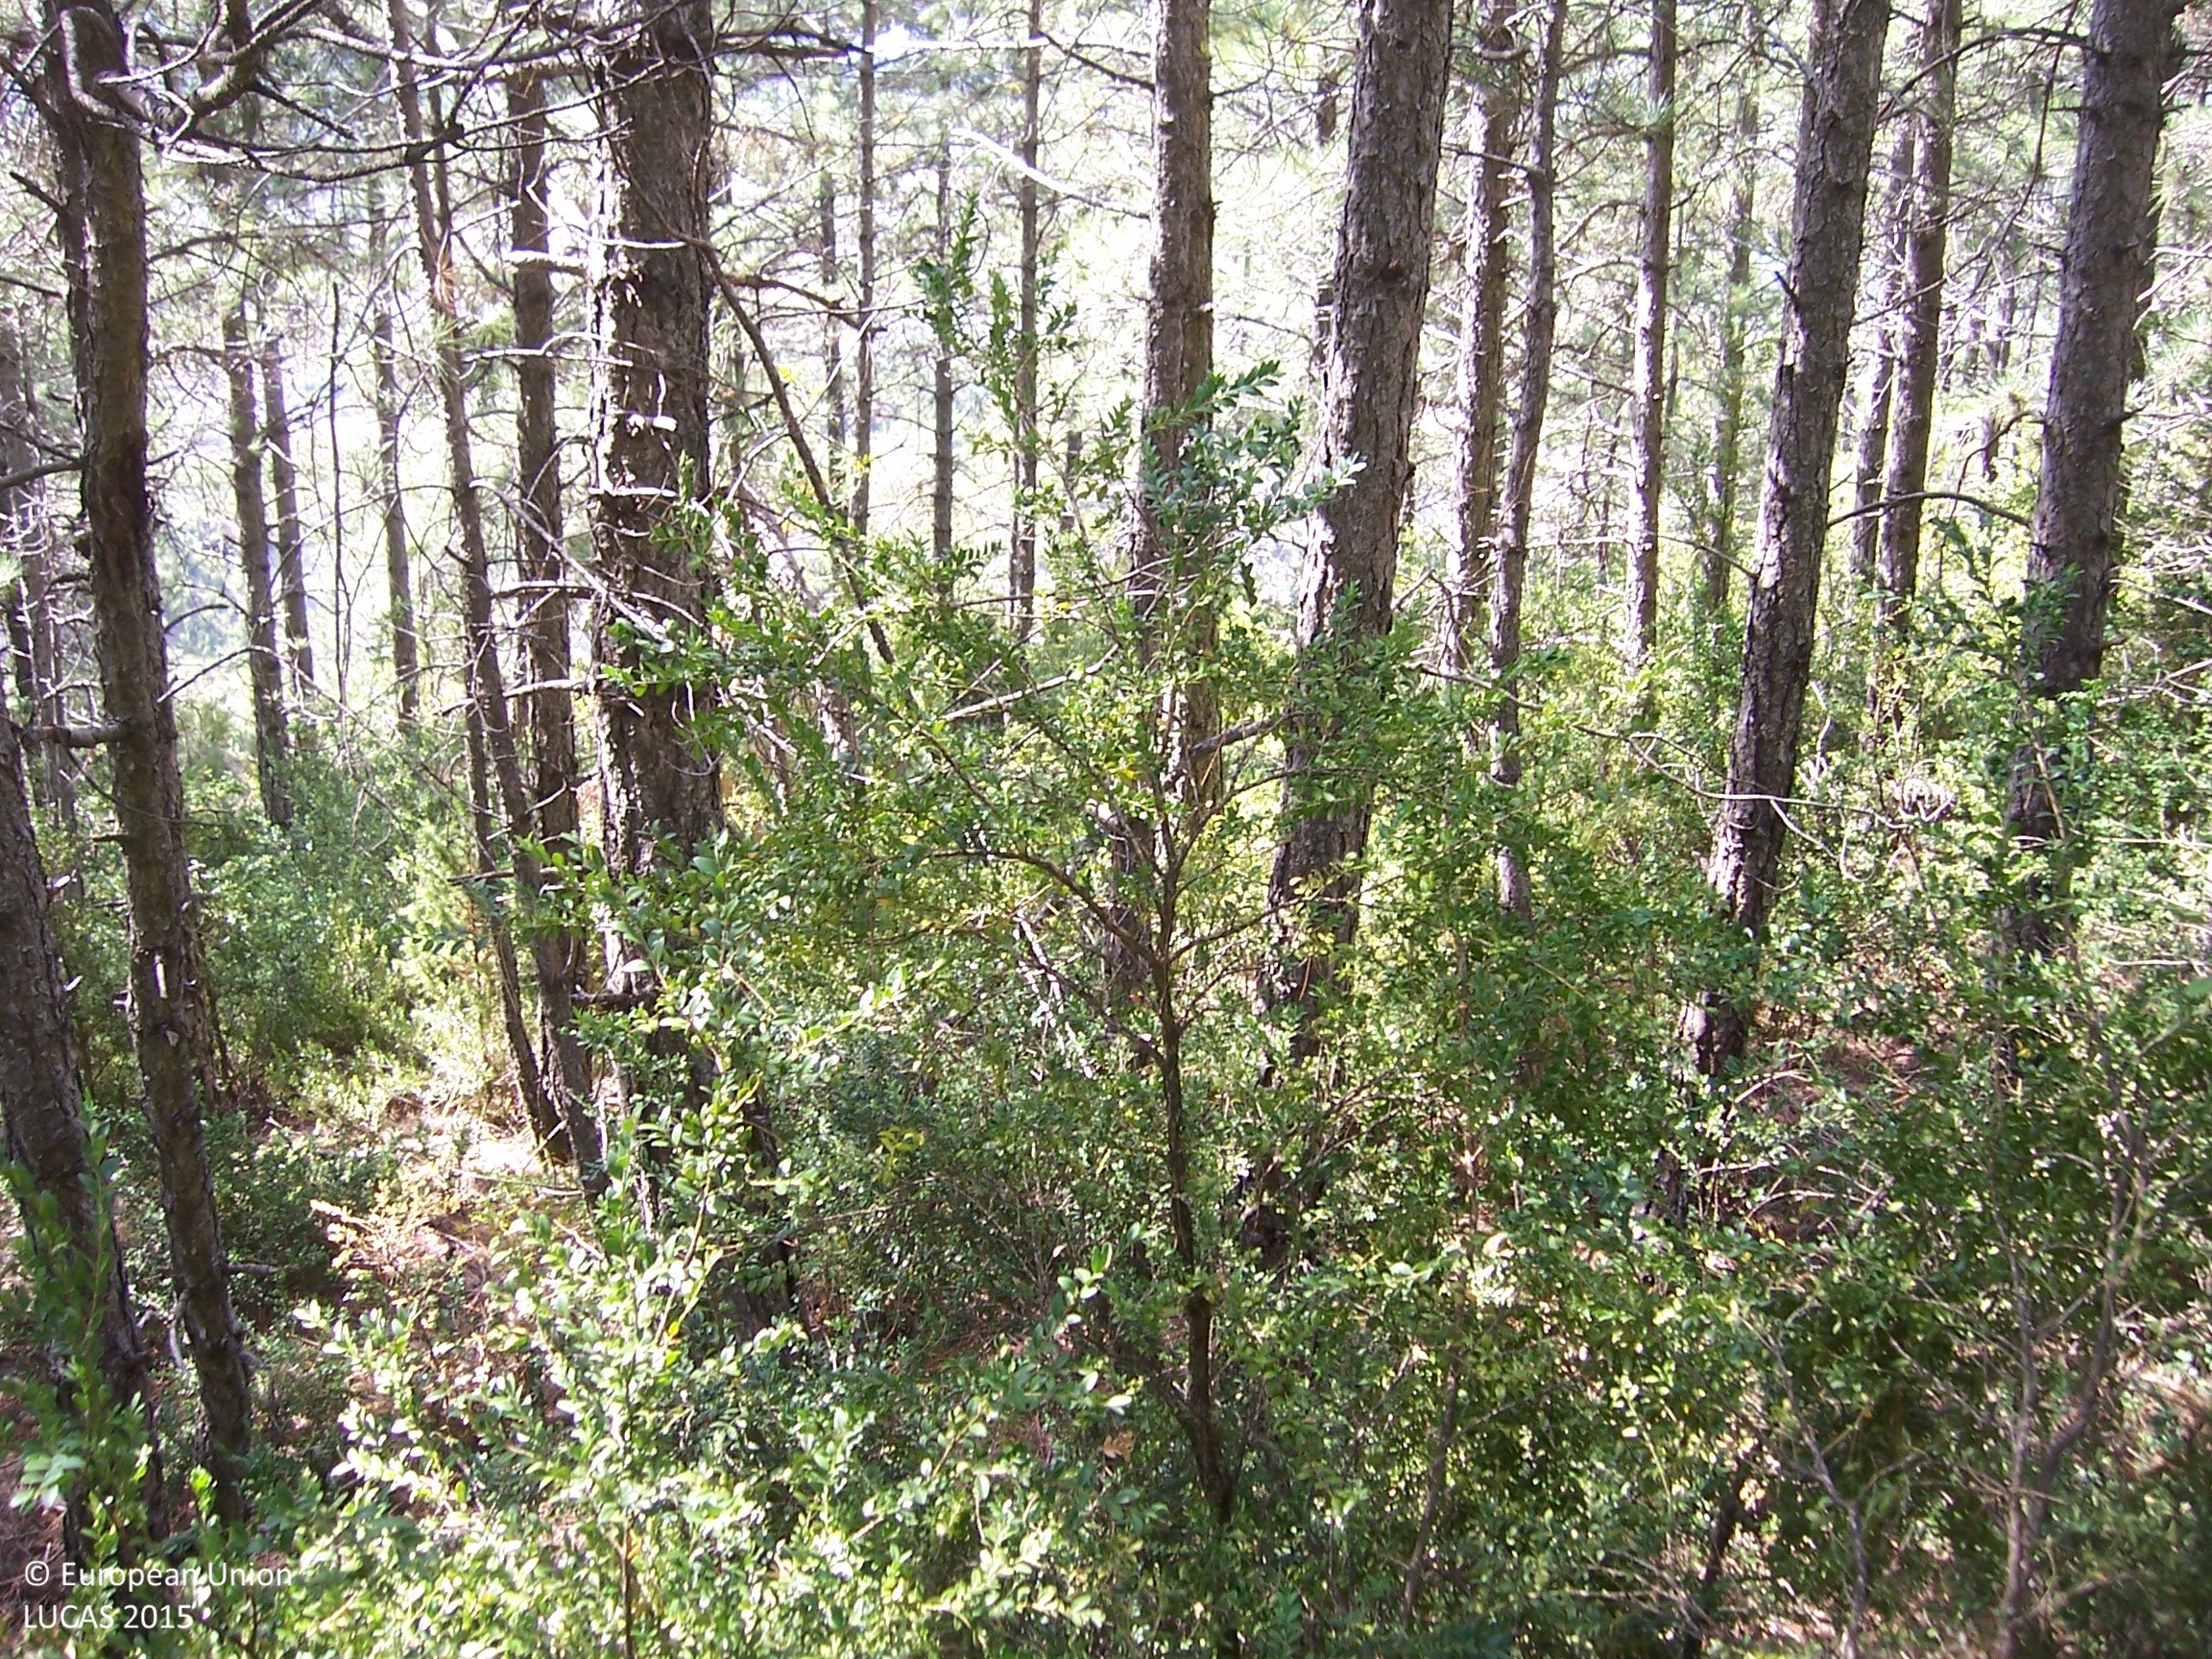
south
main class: Woodland
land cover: Pine dominated coniferous woodland
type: coniferous forest of the mediterranean region
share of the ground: > 75 %
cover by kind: coniferous forest trees 100 %
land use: Forestry
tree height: > 5 m
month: August
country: ES
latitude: 42.5856
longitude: -0.4448
